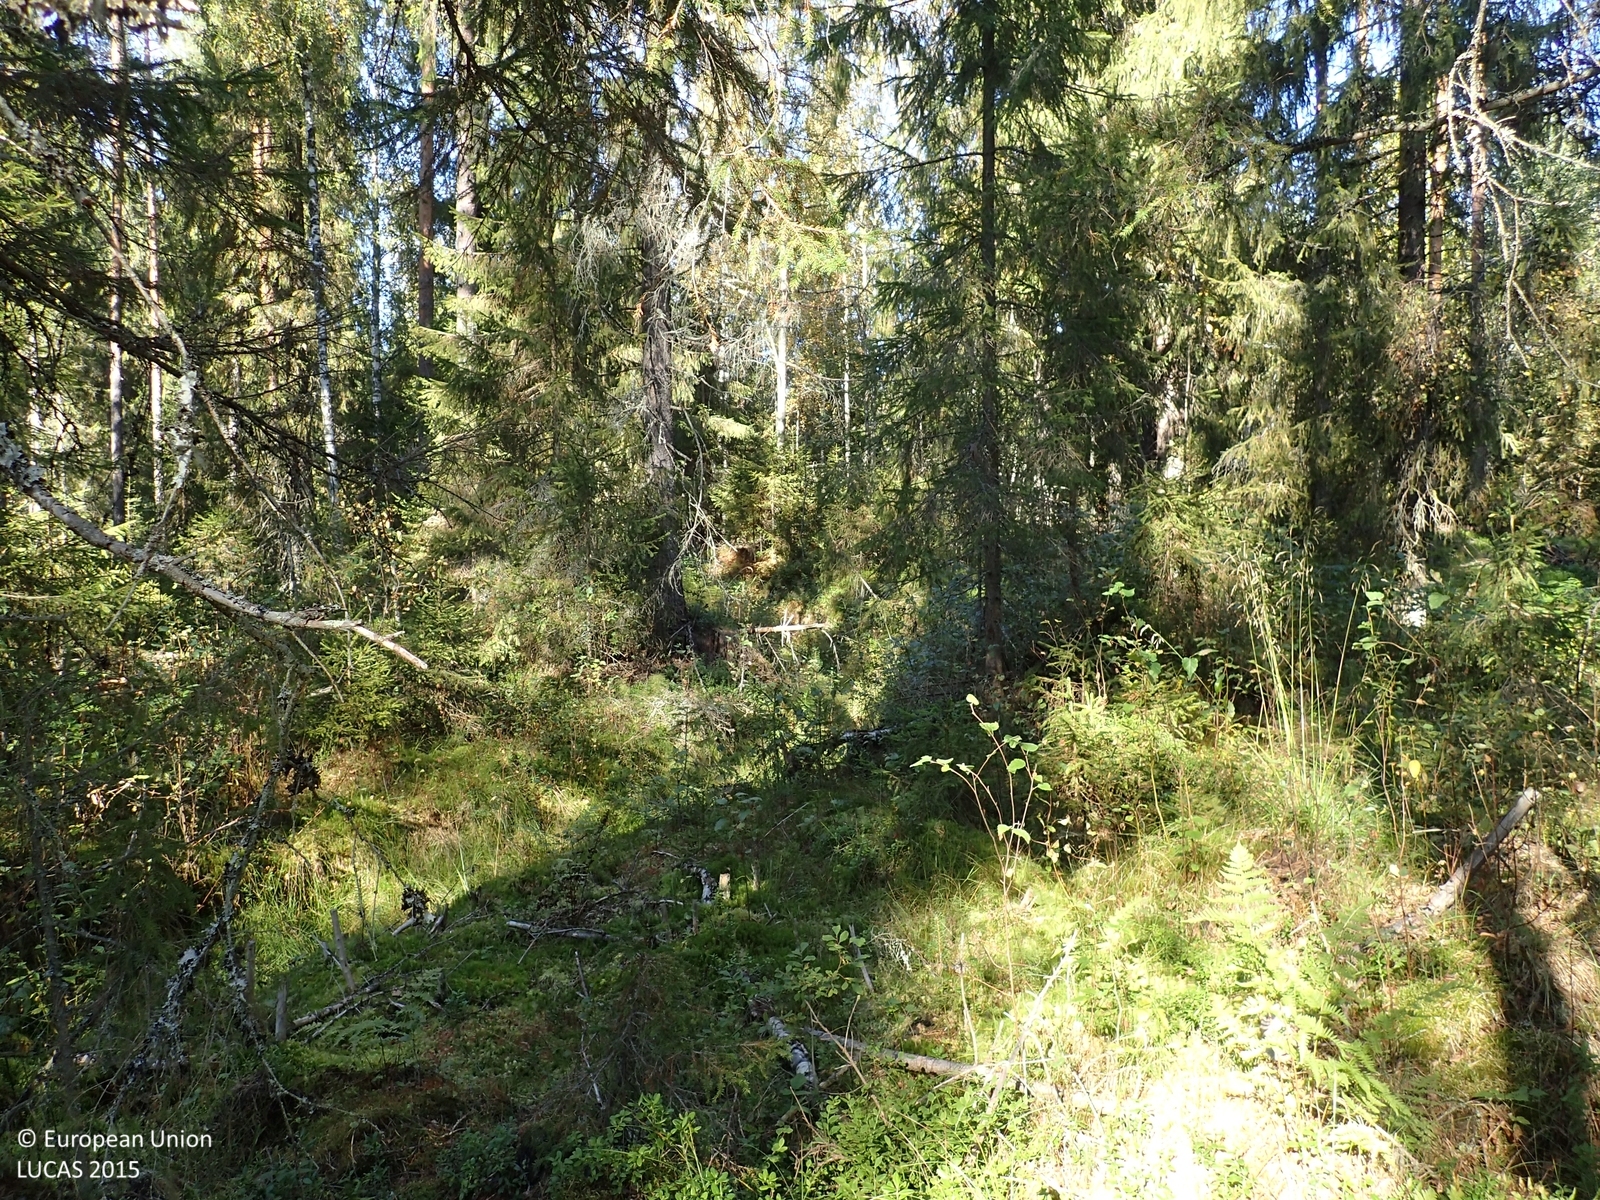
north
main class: Woodland
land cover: Spruce dominated coniferous woodland
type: boreal forest
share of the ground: > 75 %
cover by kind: coniferous forest trees 65 %, shrubs 20 %, broadleaved forest trees 10 %, herbaceous plants 5 %
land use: Forestry
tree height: > 5 m
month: September
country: FI
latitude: 62.9153
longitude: 25.4422
